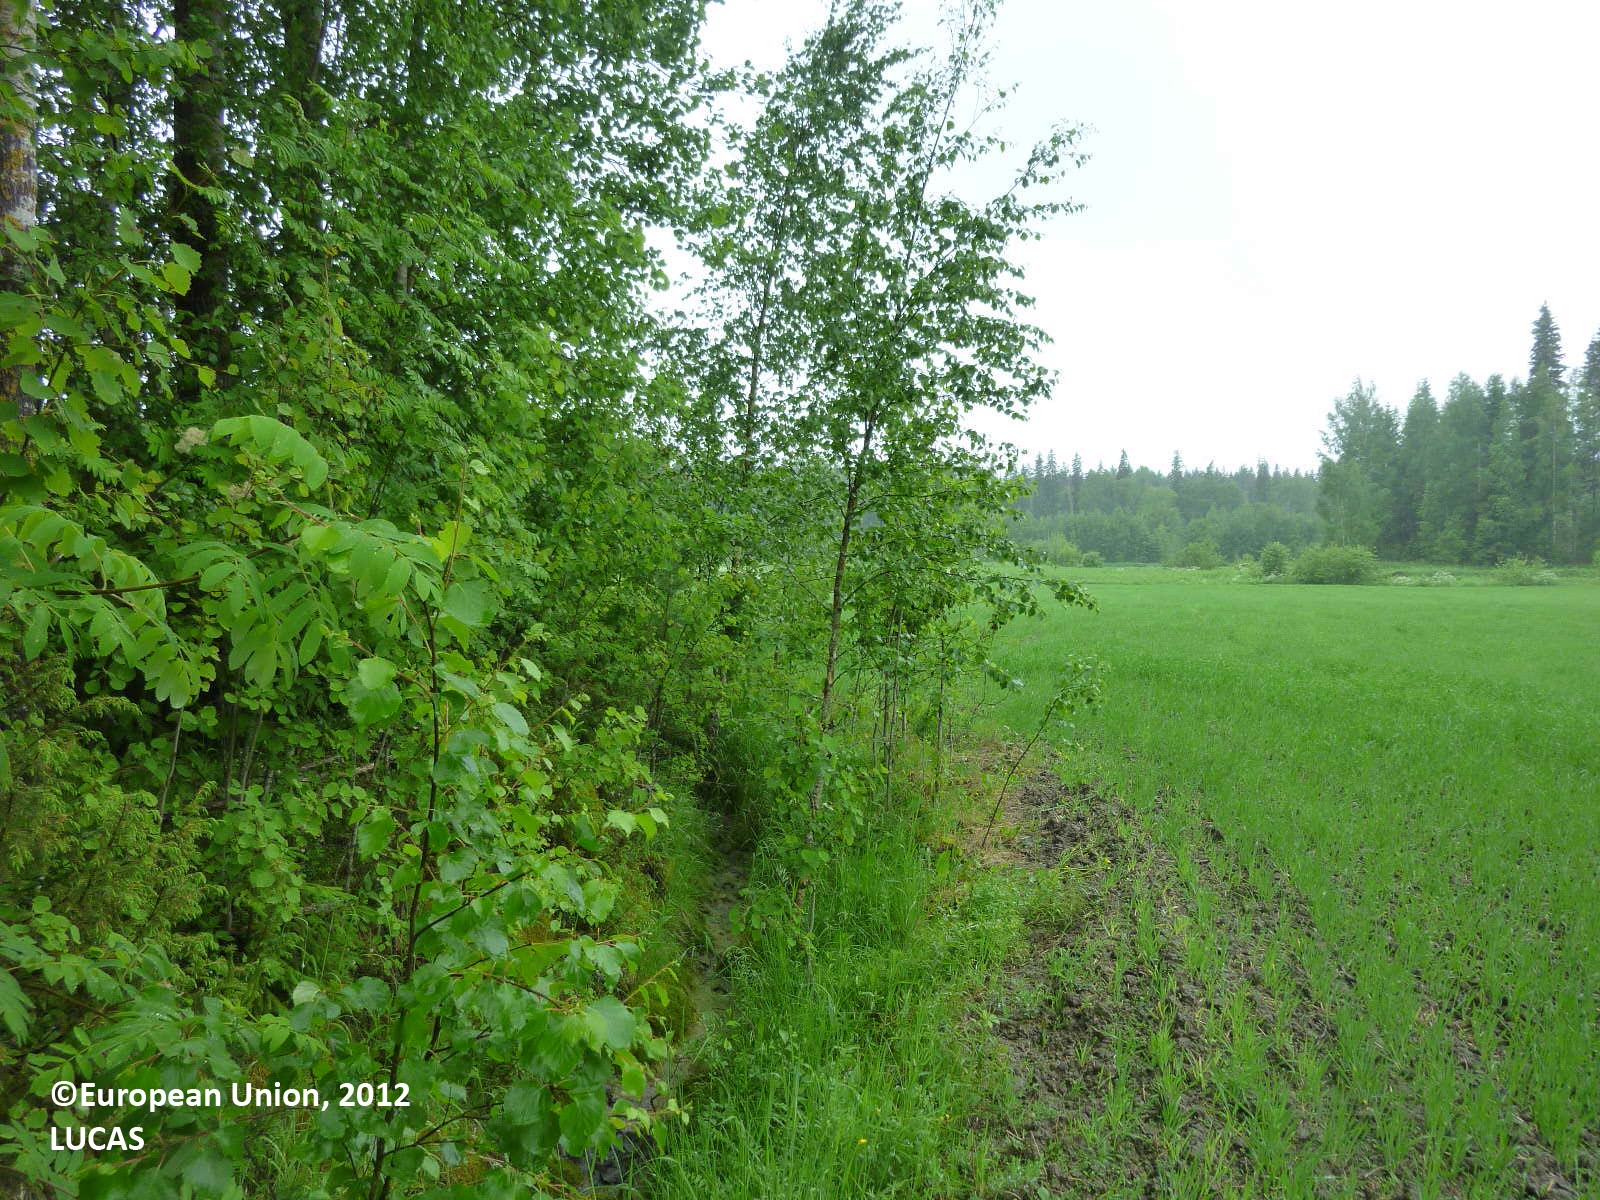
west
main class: Cropland
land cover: Barley
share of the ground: > 75 %
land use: Agriculture (excluding fallow land and kitchen gardens)
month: June
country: FI
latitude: 61.6094
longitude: 22.3335
